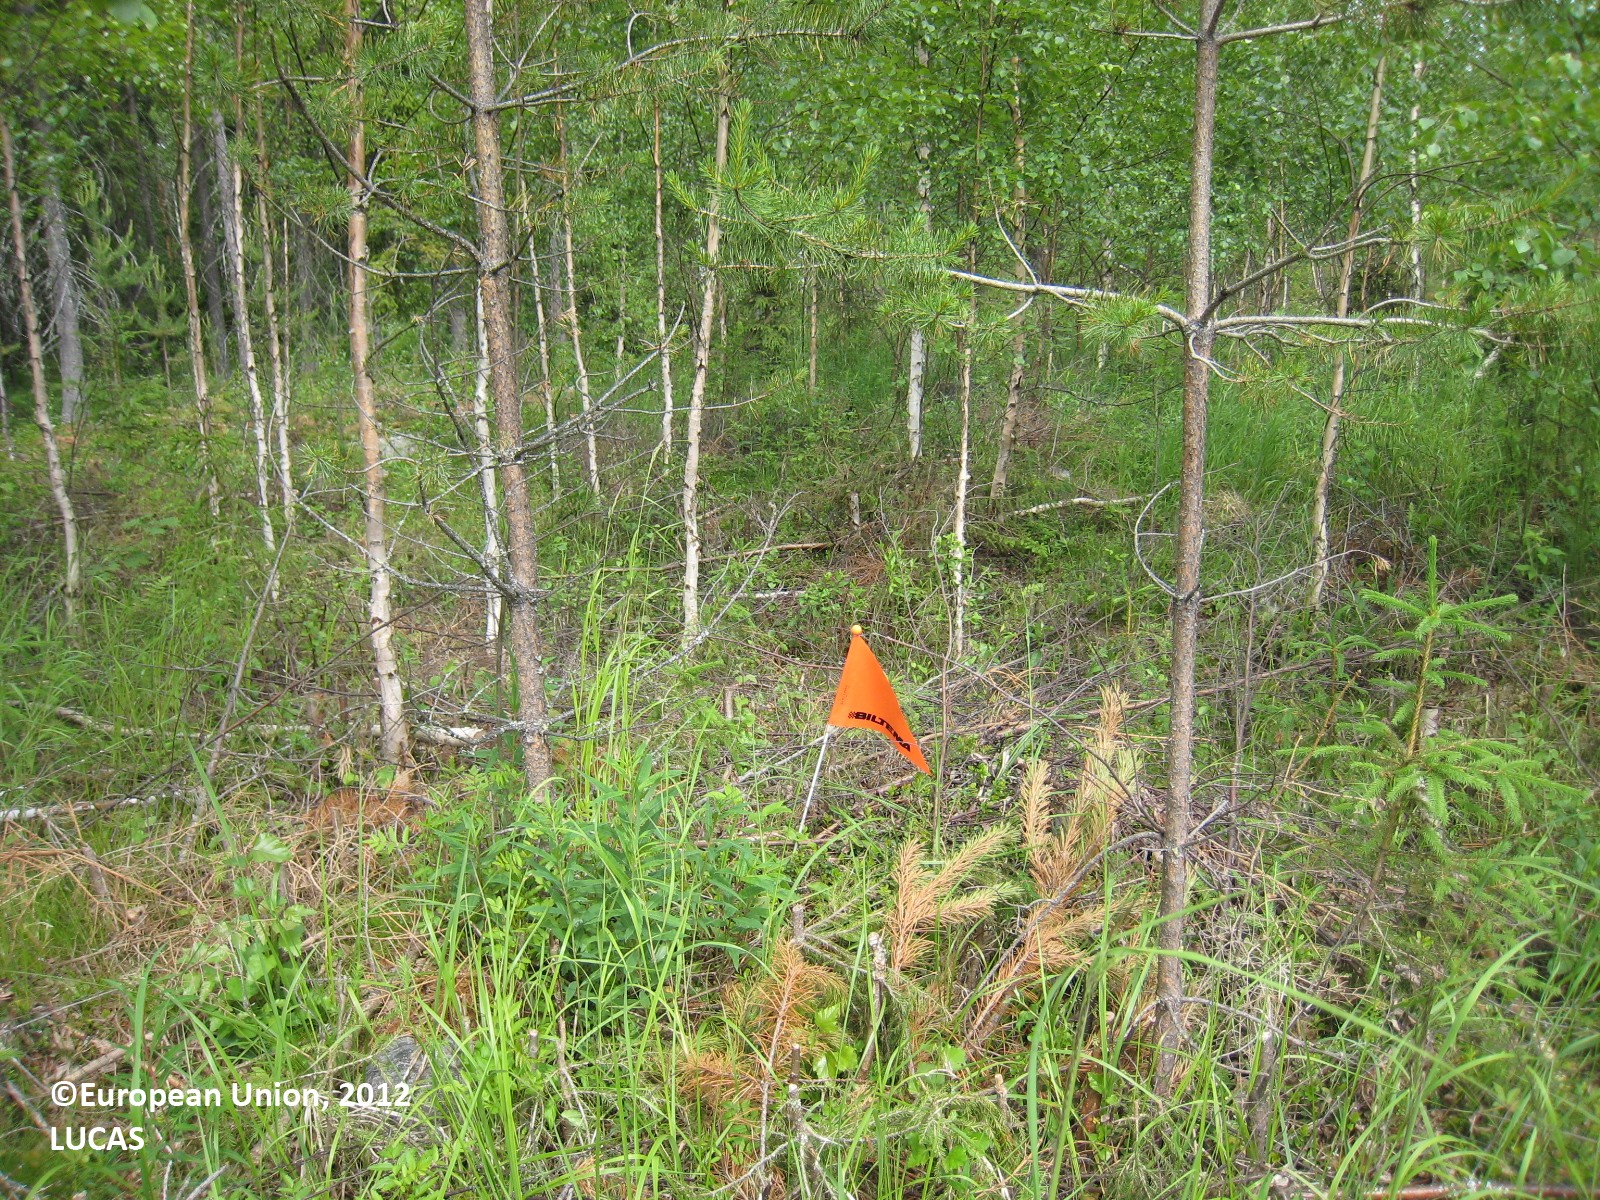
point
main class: Woodland
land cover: Broadleaved woodland
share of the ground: 50 - 75 %
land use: Forestry
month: June
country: FI
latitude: 62.2223
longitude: 26.3901
